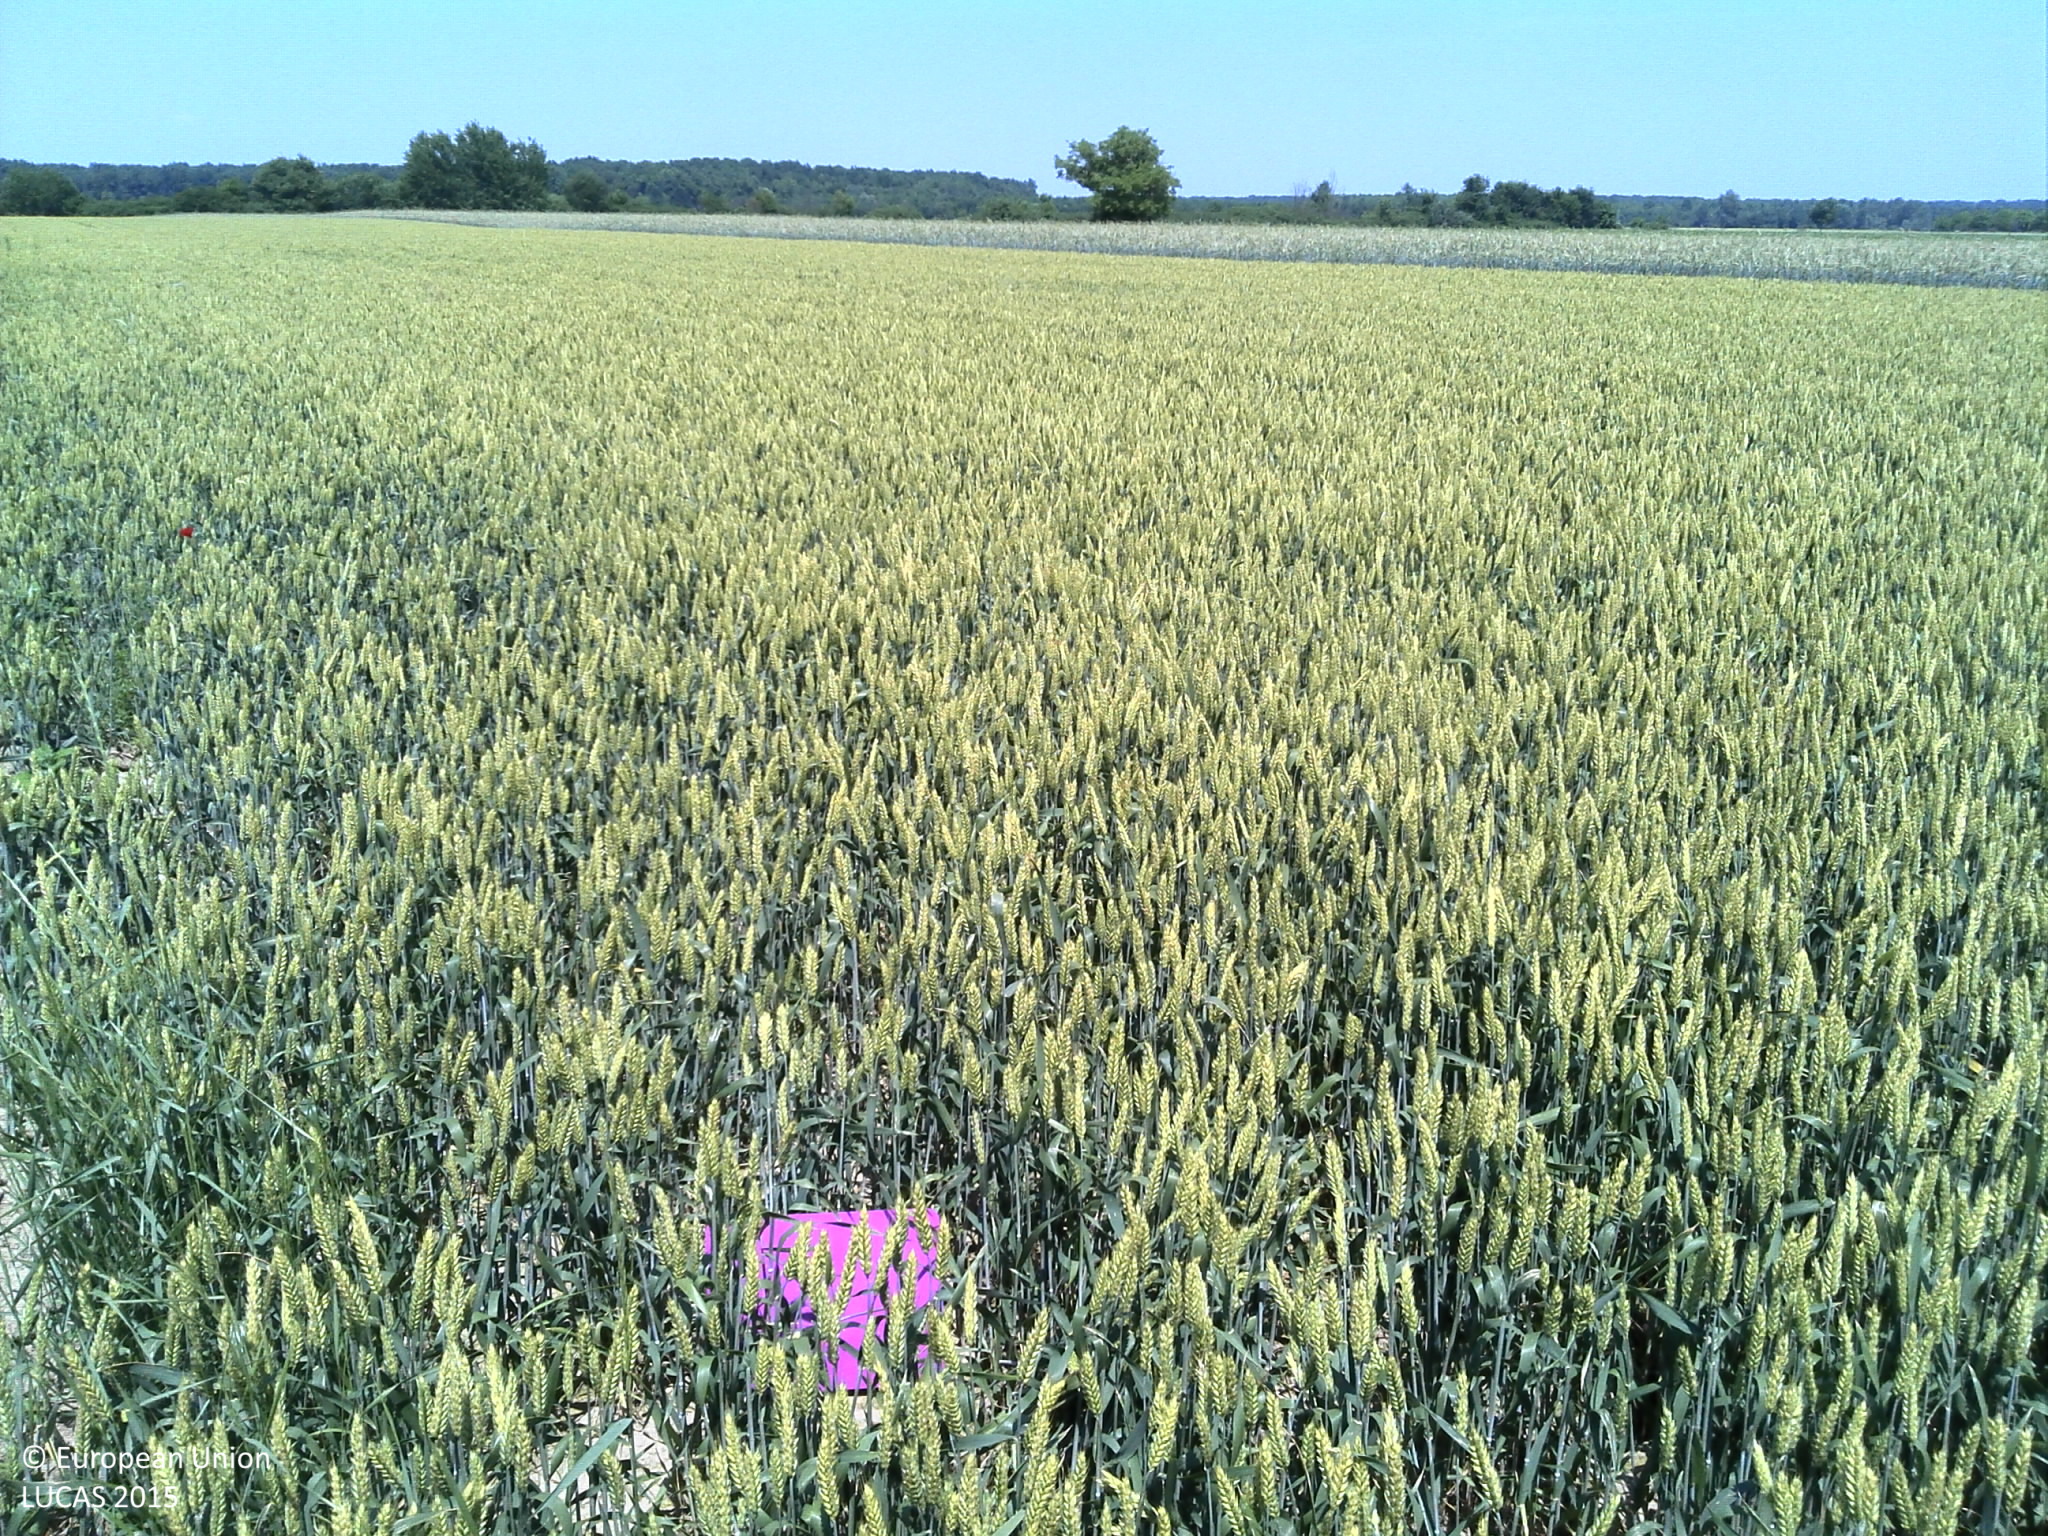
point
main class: Cropland
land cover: Common wheat
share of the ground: > 75 %
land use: Agriculture (excluding fallow land and kitchen gardens)
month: June
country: HR
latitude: 44.9567
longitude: 18.9944
